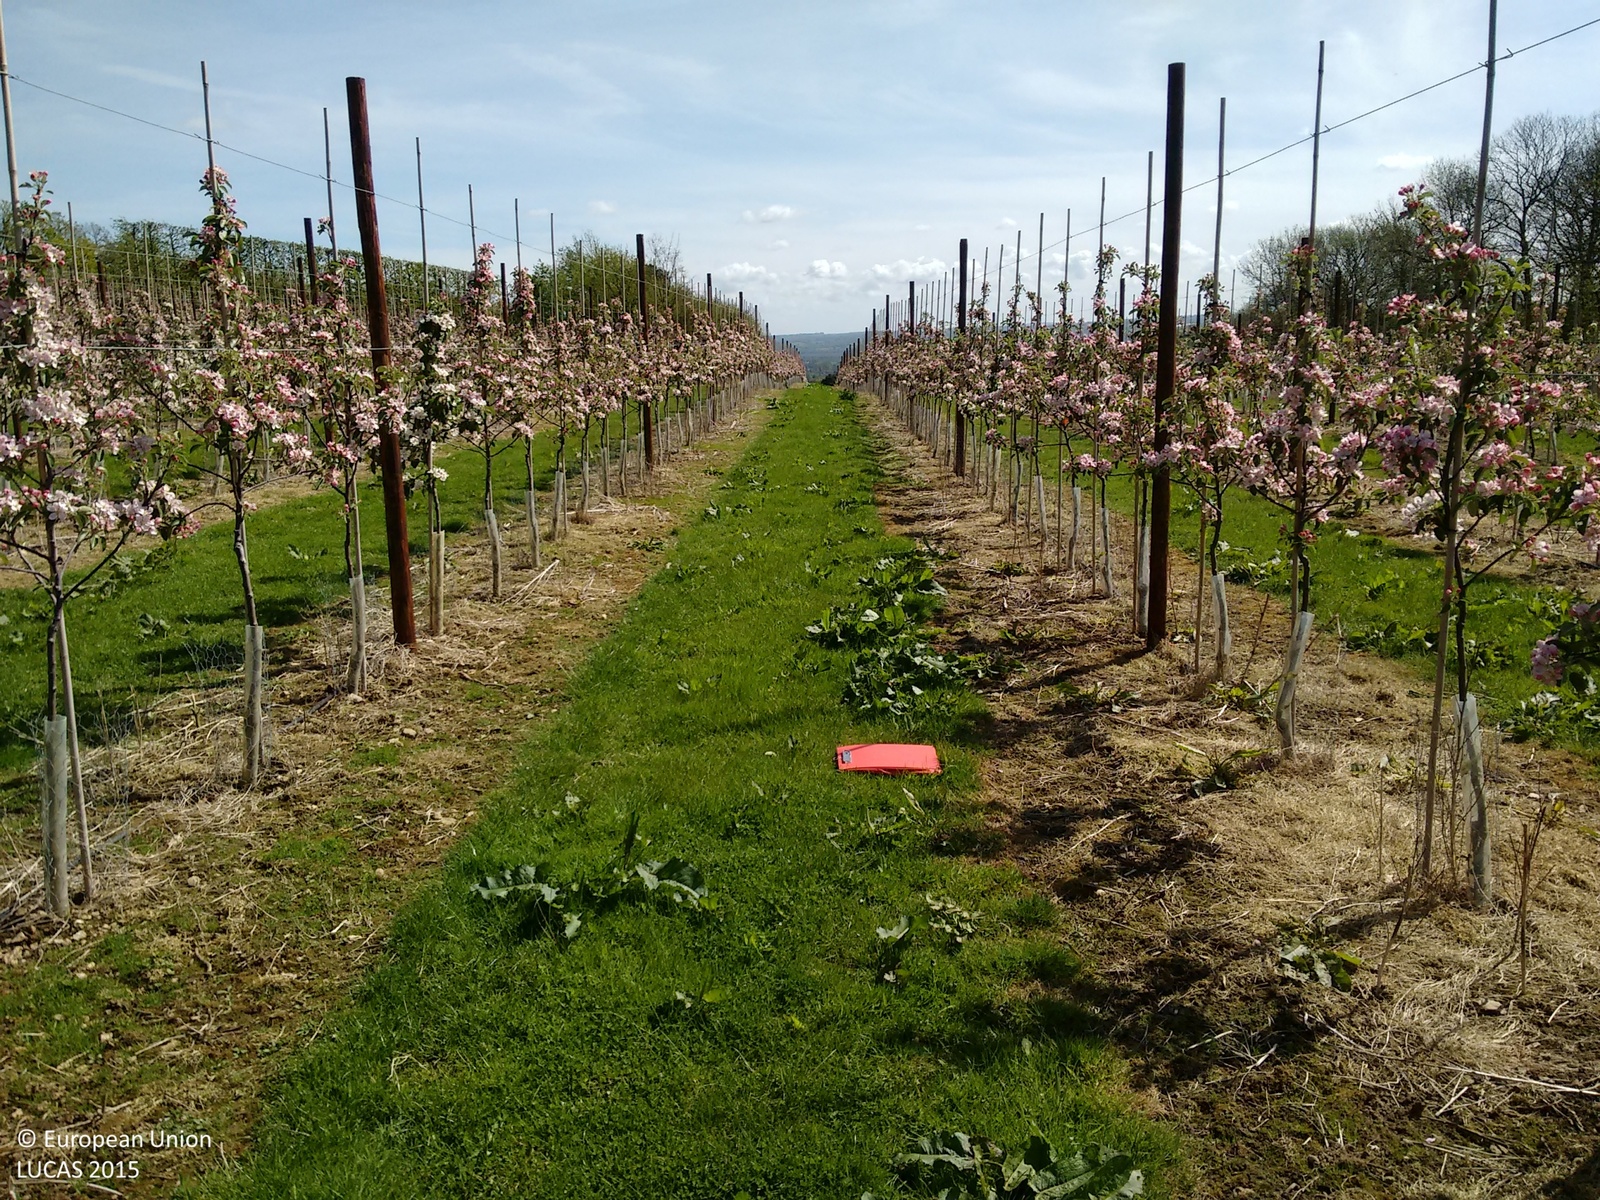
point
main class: Cropland
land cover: Apple fruit
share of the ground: 25 - 50 %
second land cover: Grassland without tree/shrub cover
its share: 50 - 75 %
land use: Agriculture (excluding fallow land and kitchen gardens)
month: May
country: GB
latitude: 51.2572
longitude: 0.3269
